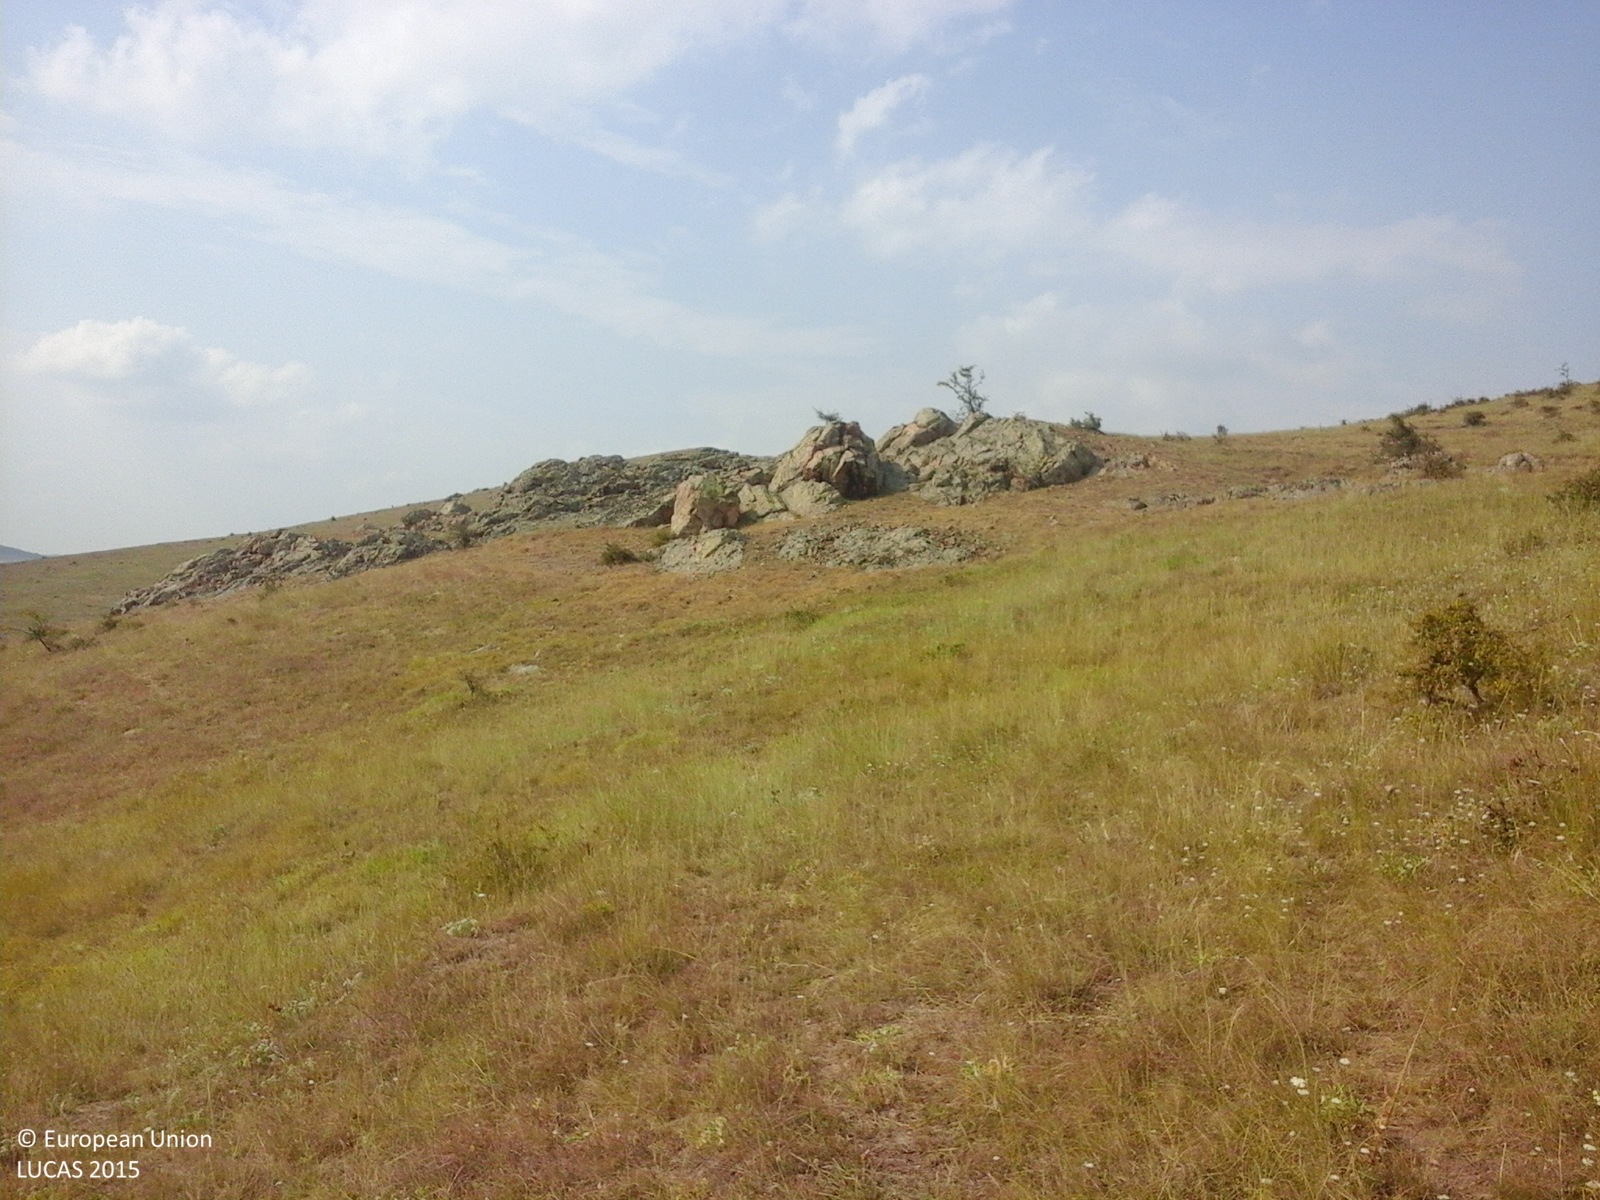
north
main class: Grassland
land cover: Grassland without tree/shrub cover
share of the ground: > 75 %
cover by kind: herbaceous plants 100 %
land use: Agriculture (excluding fallow land and kitchen gardens)
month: July
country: RO
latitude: 45.0772
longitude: 28.4586
